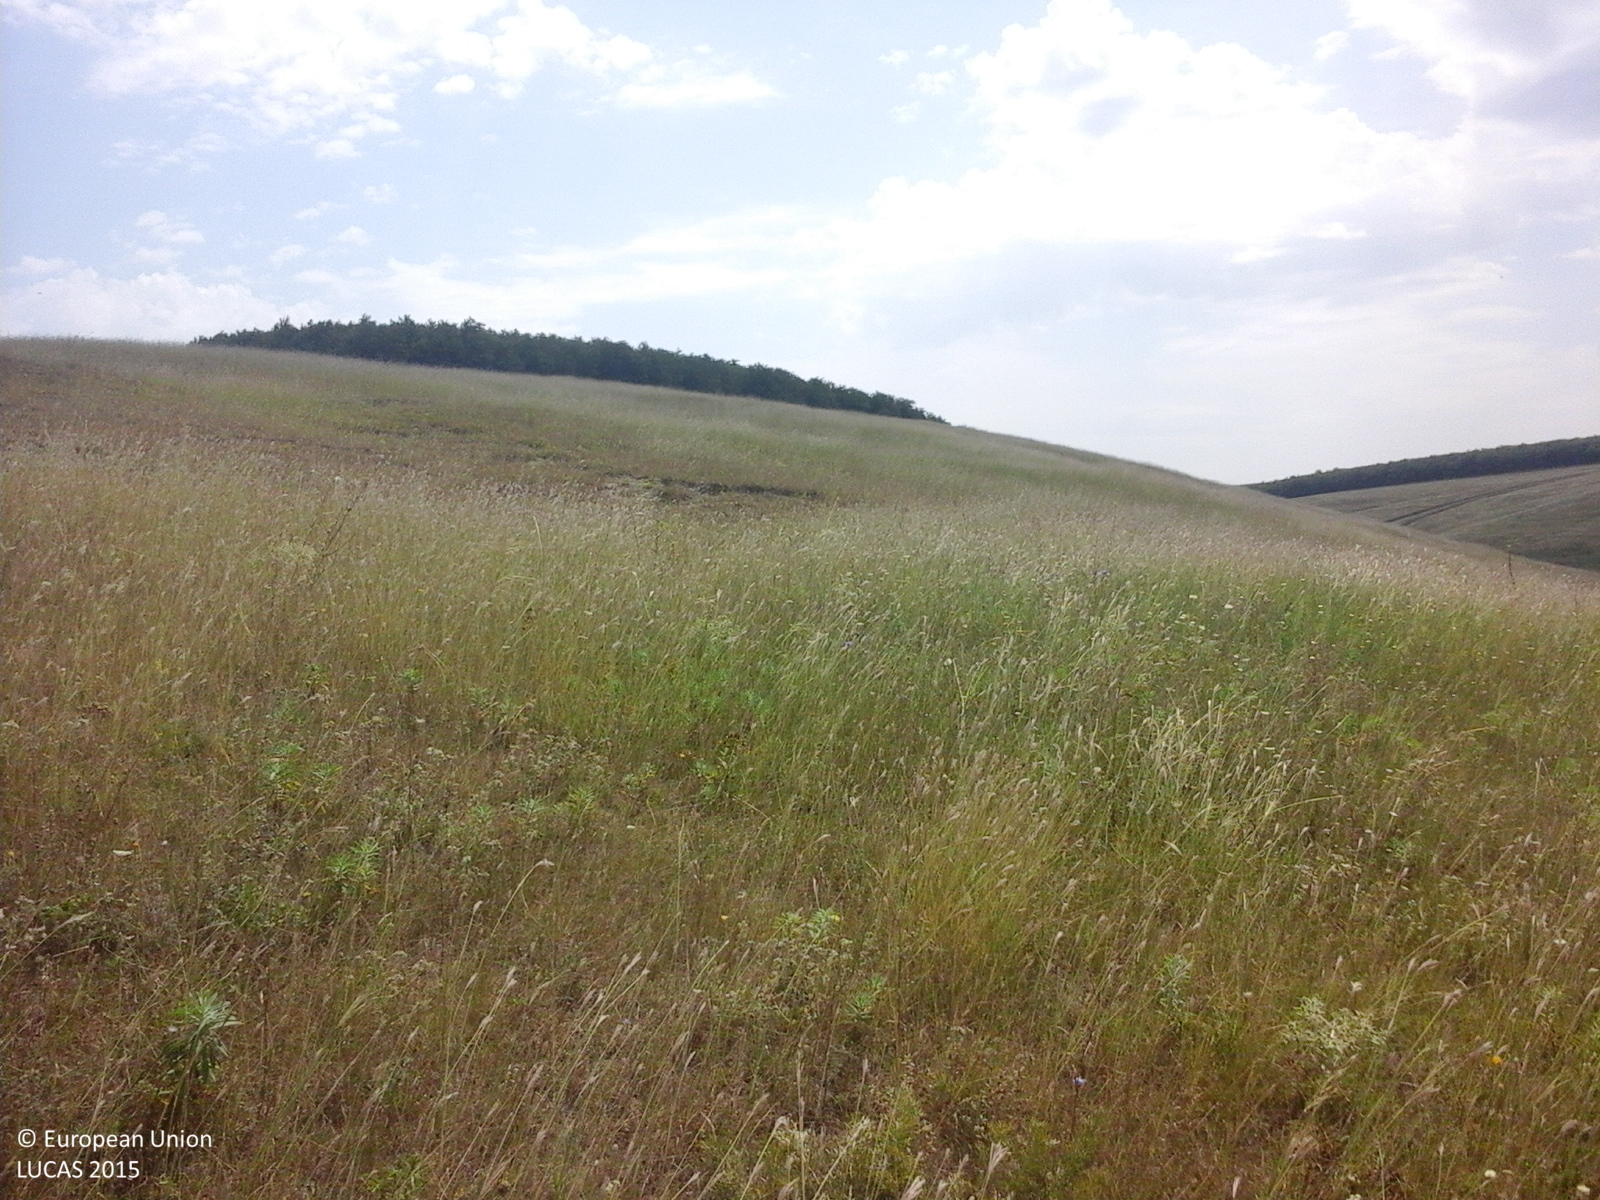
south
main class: Grassland
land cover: Grassland without tree/shrub cover
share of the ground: > 75 %
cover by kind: herbaceous plants 100 %
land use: Agriculture (excluding fallow land and kitchen gardens)
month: August
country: RO
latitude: 44.1888
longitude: 28.0587
